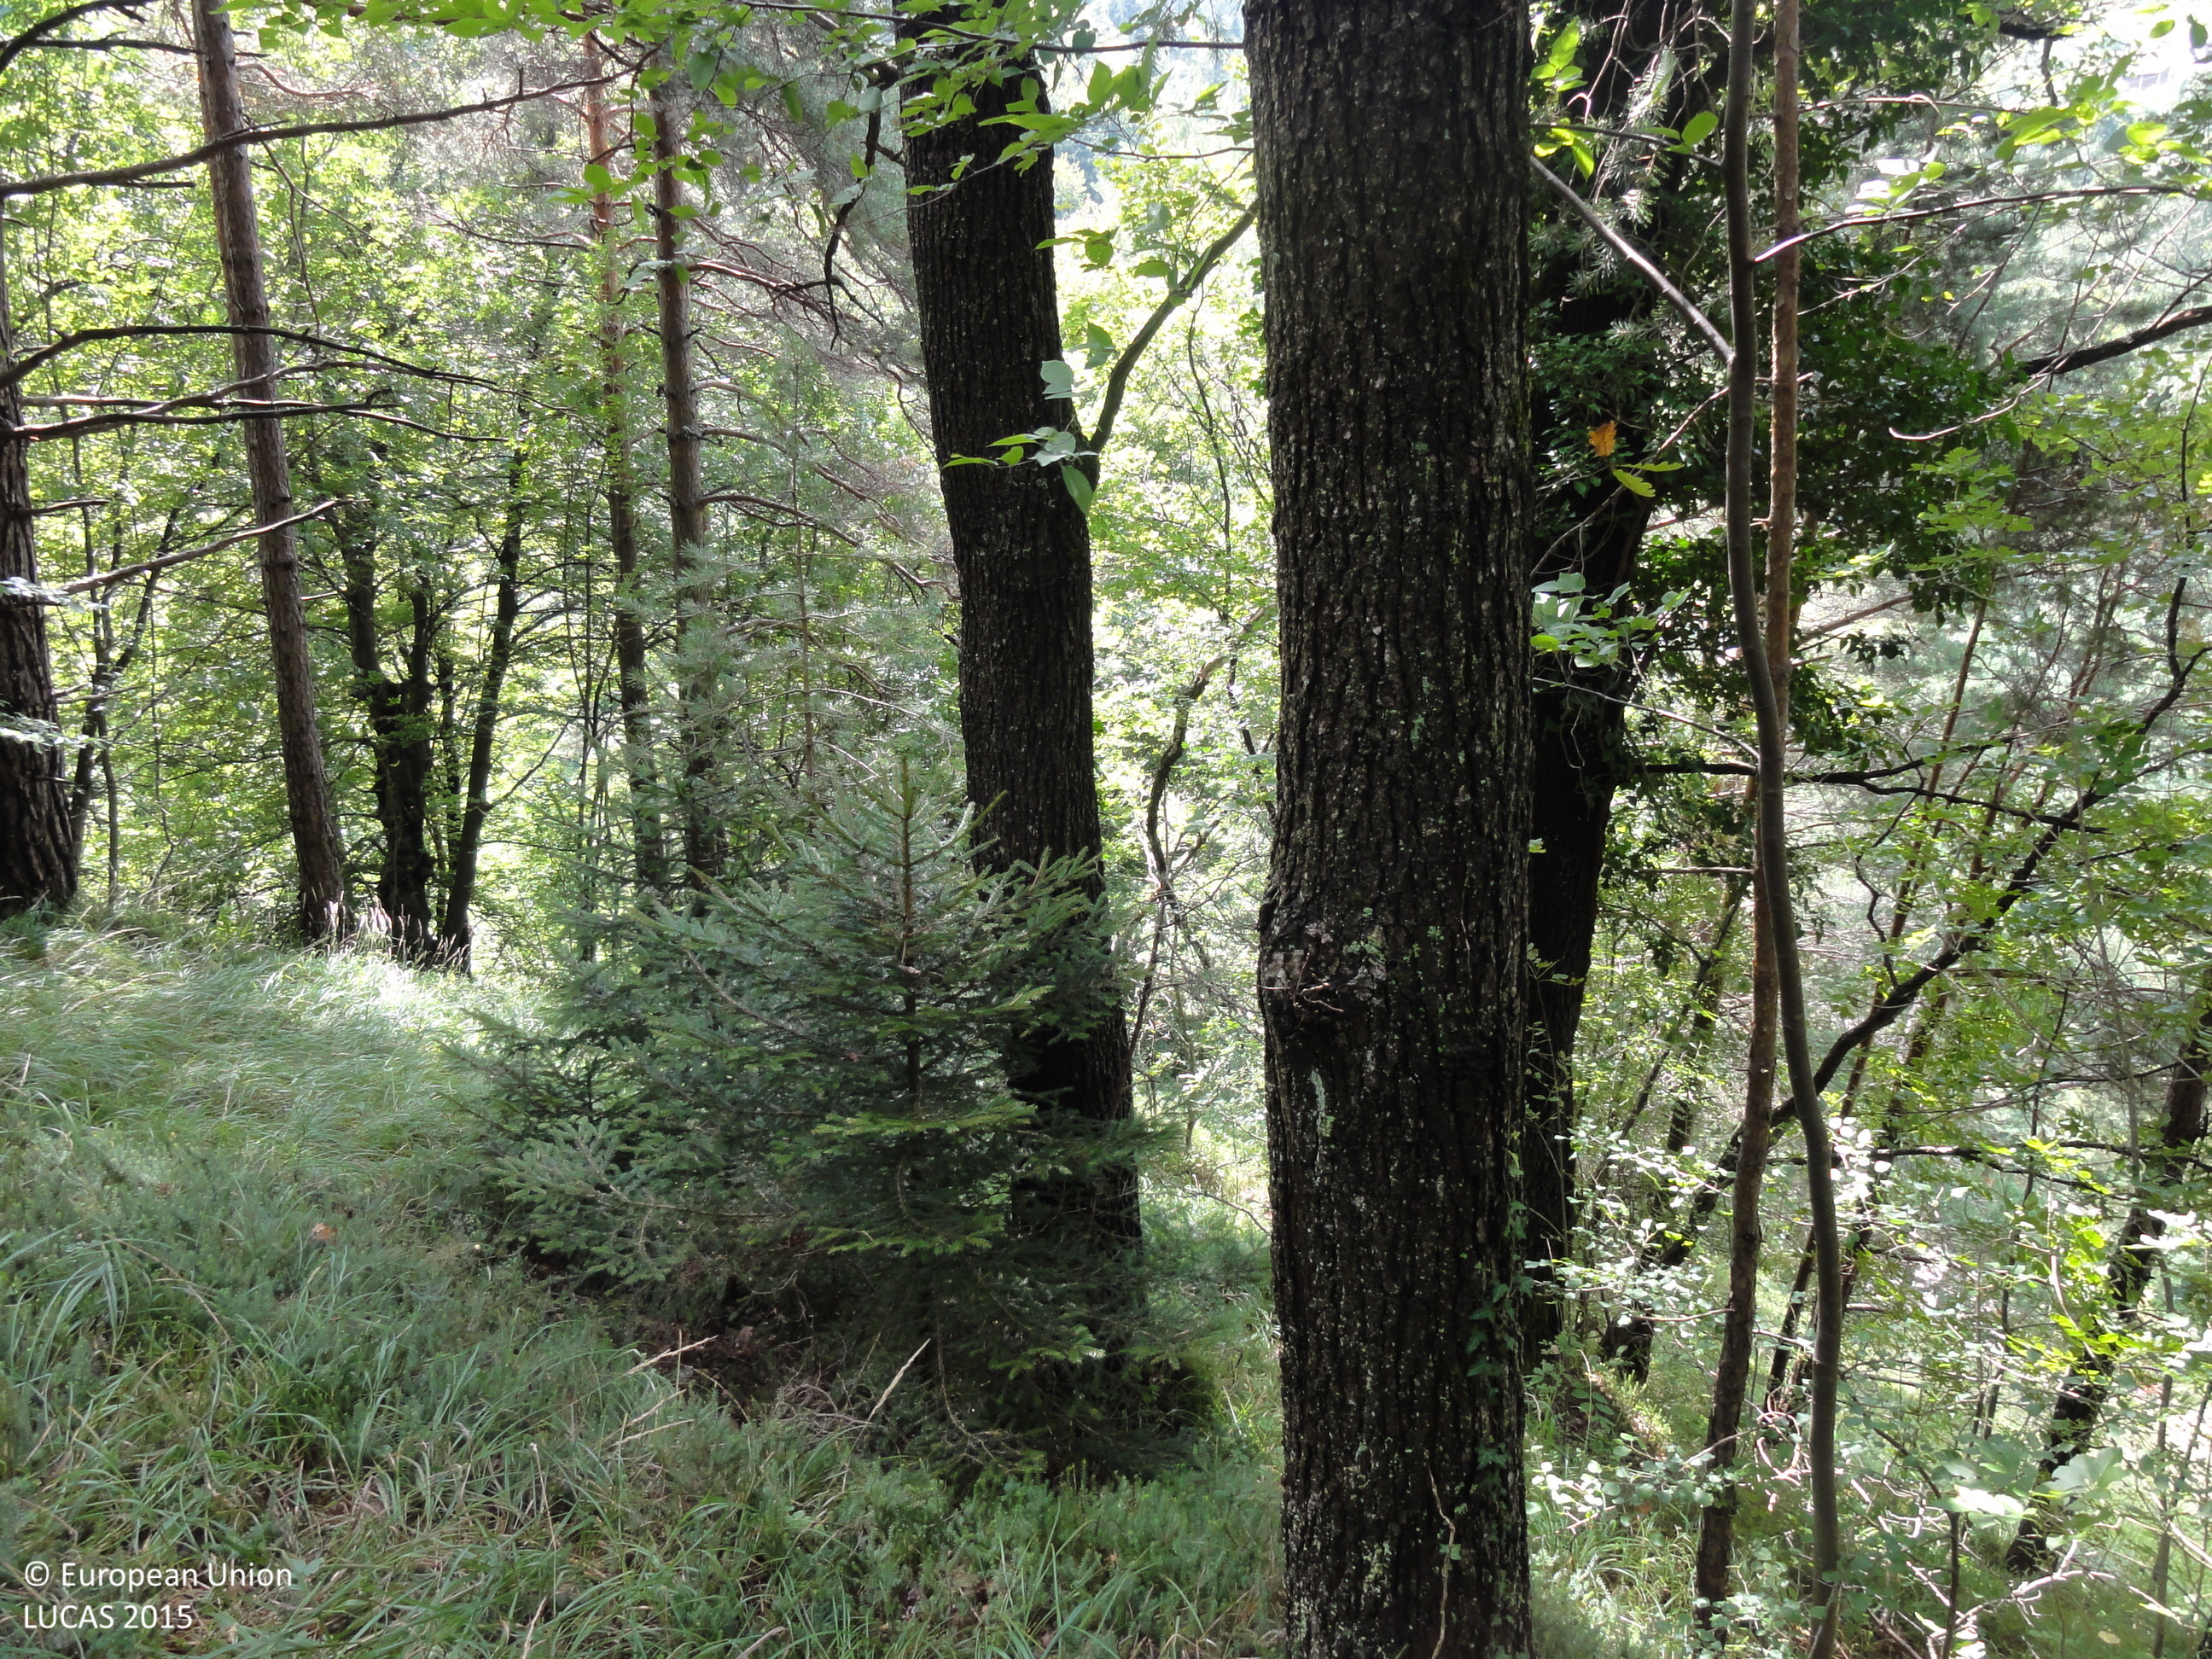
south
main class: Woodland
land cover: Pine dominated mixed woodland
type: hemiboreal forest and nemoral coniferous forest and mixed broadleaved-coniferous forest
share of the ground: > 75 %
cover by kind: coniferous forest trees 70 %, broadleaved forest trees 30 %
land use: Forestry
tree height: > 5 m
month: August
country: SI
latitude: 46.0886
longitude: 15.0280
